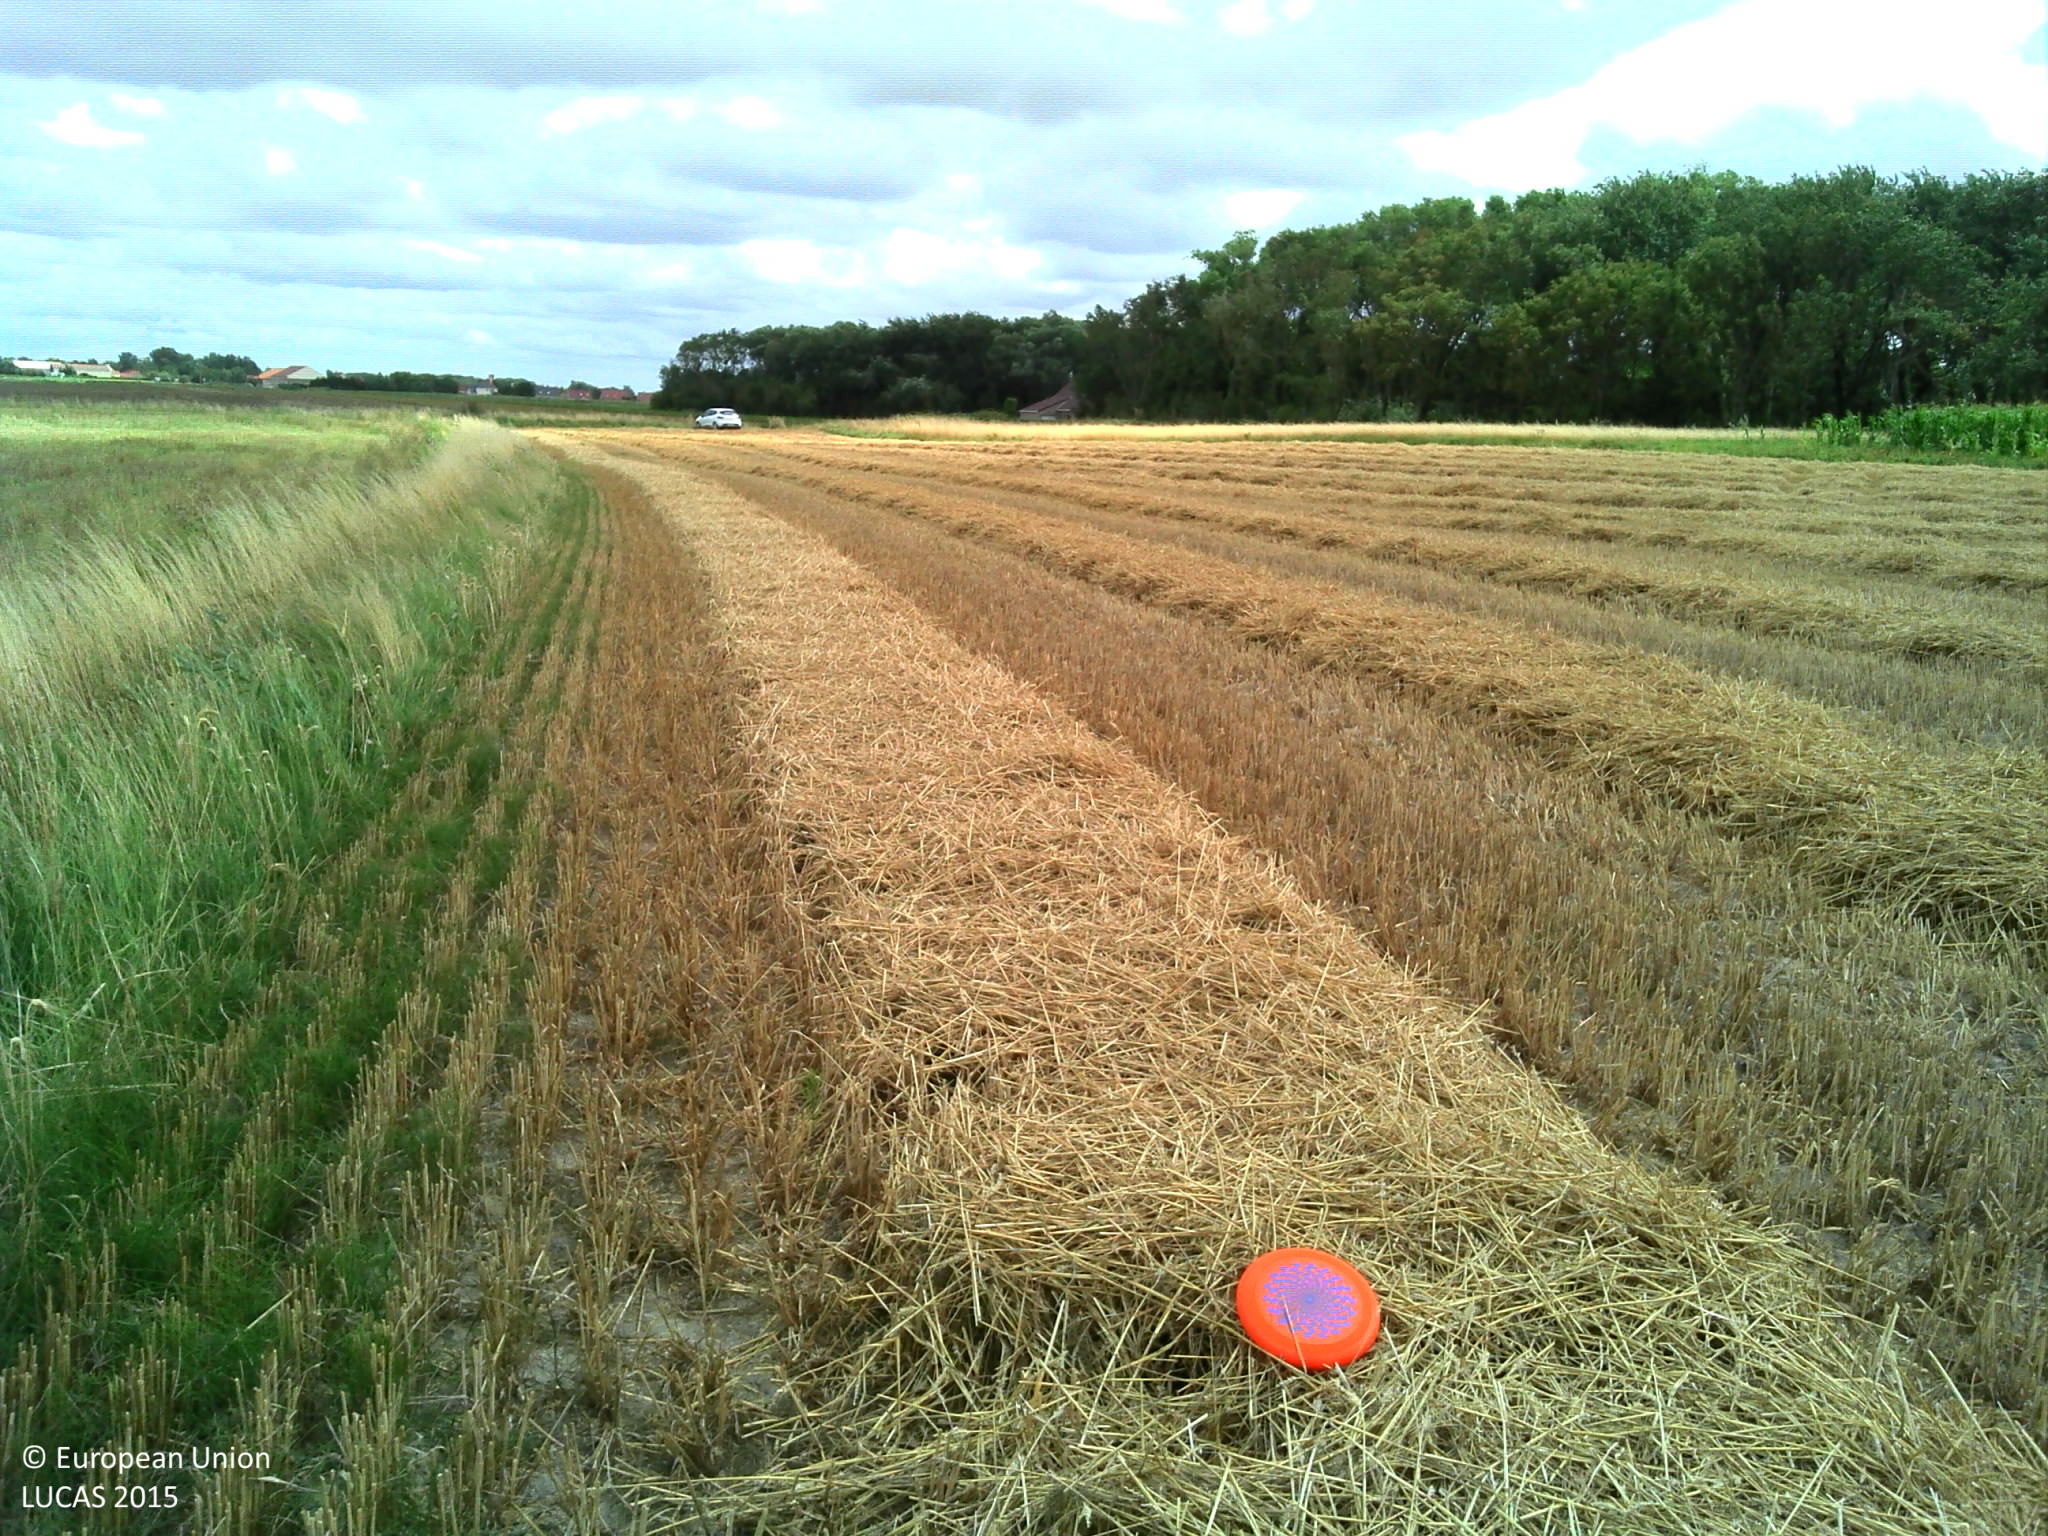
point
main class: Cropland
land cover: Common wheat
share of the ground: 50 - 75 %
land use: Agriculture (excluding fallow land and kitchen gardens)
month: August
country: FR
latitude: 50.9885
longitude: 2.0206
